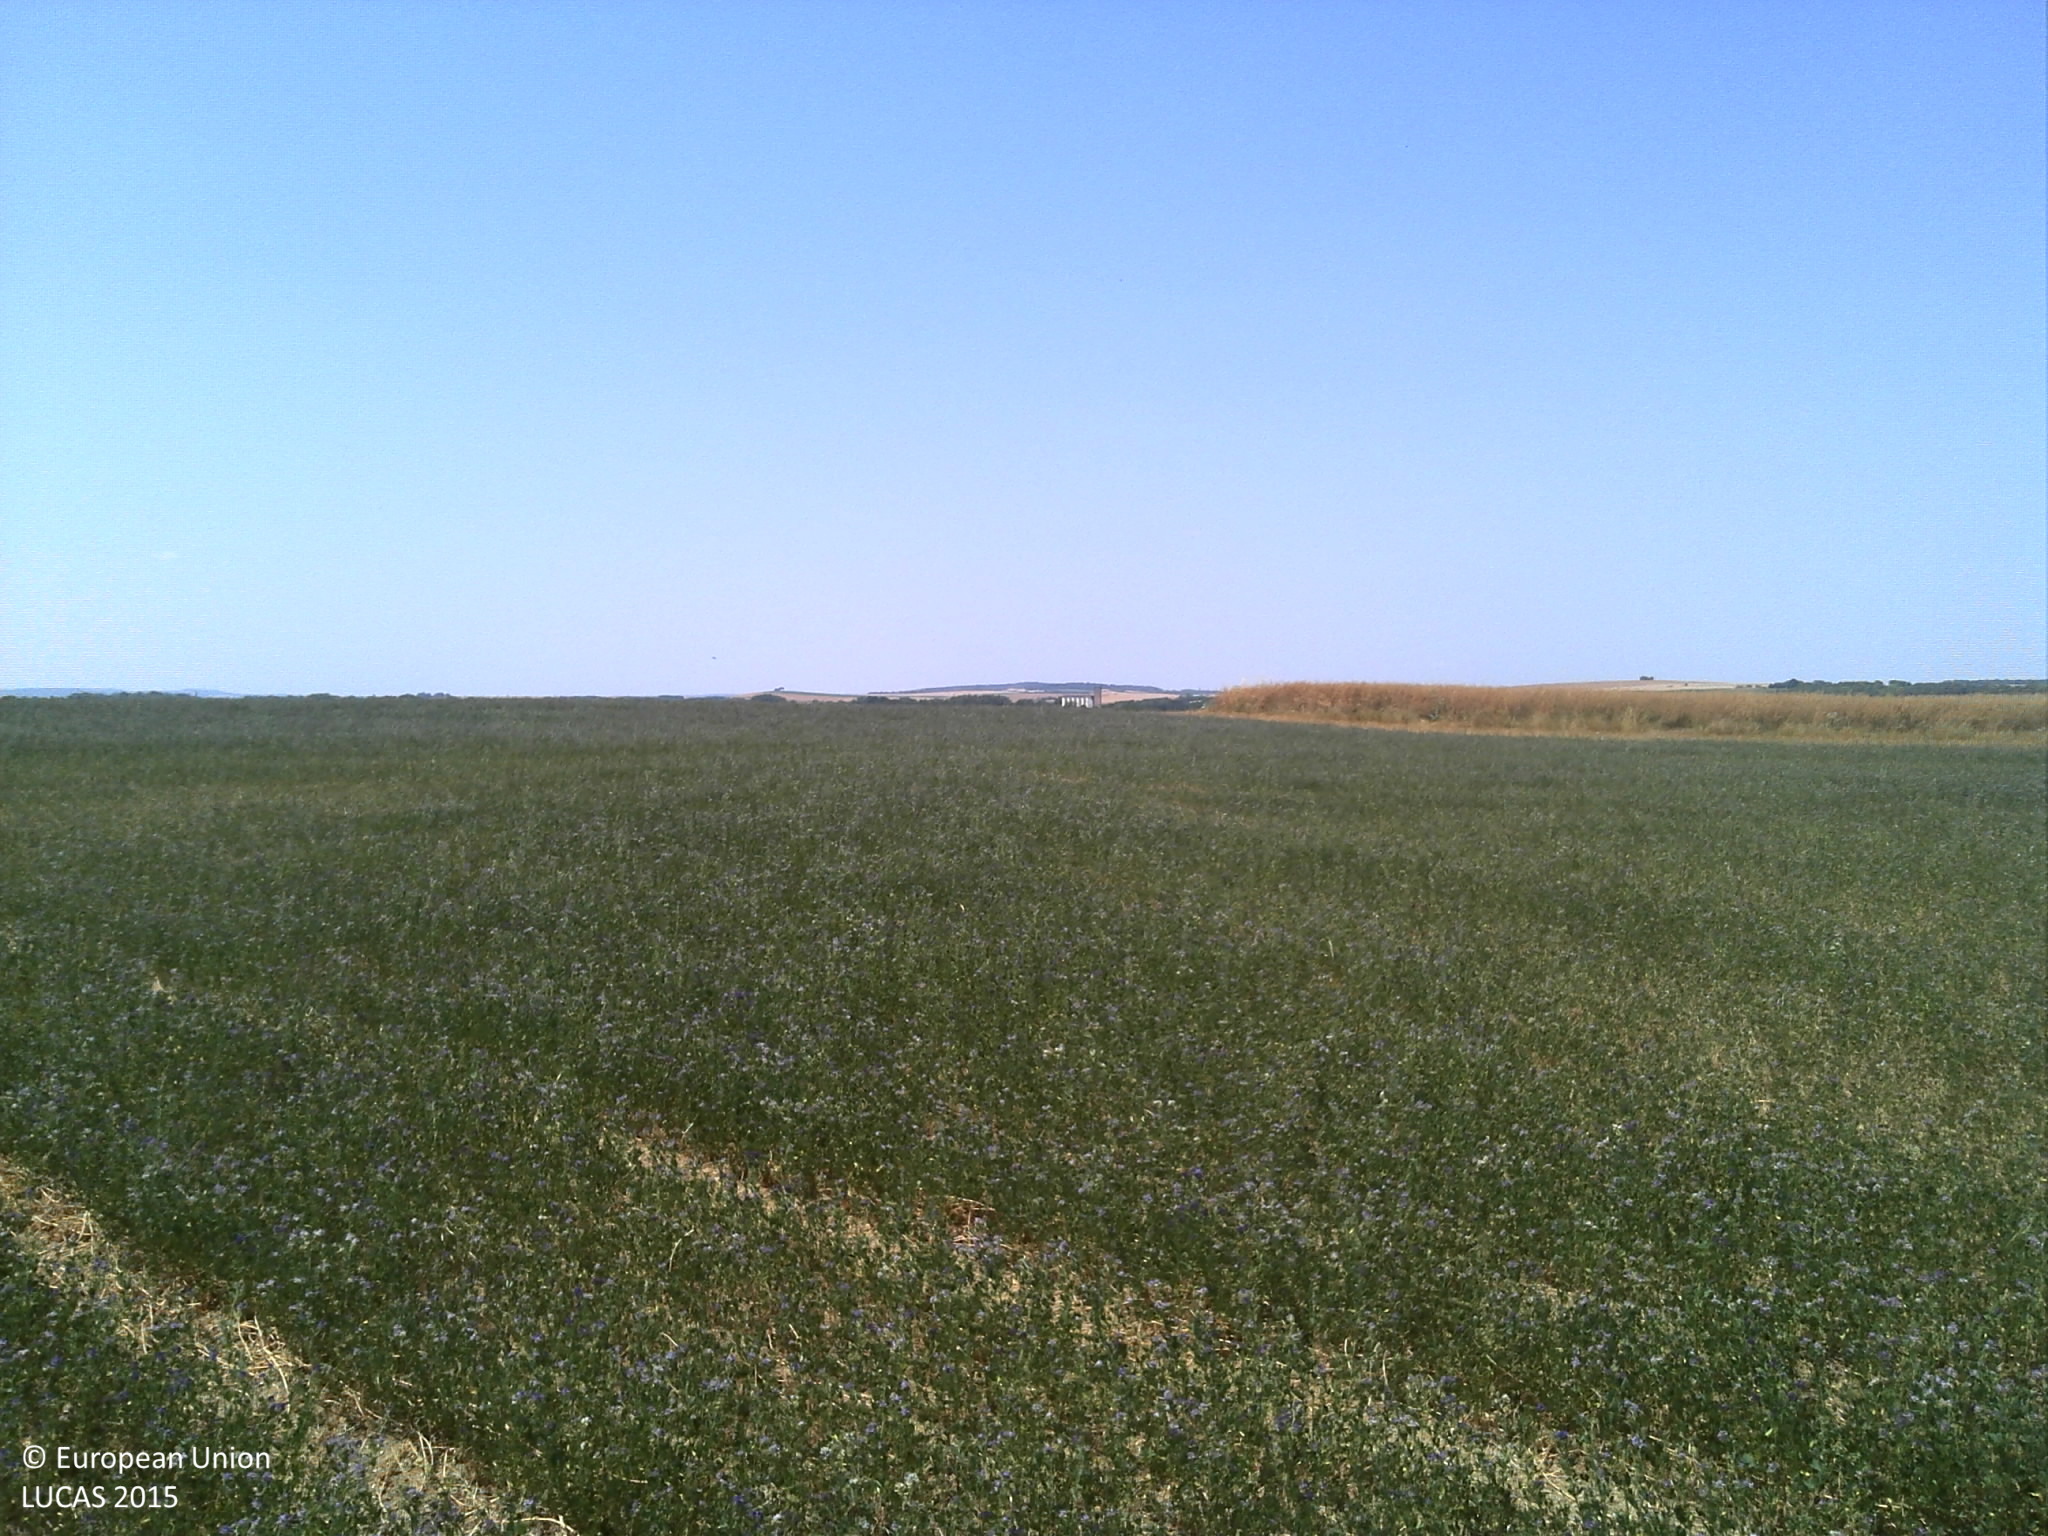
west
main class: Cropland
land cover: Lucerne
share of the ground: > 75 %
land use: Agriculture (excluding fallow land and kitchen gardens)
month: July
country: FR
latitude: 49.4561
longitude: 4.1320
